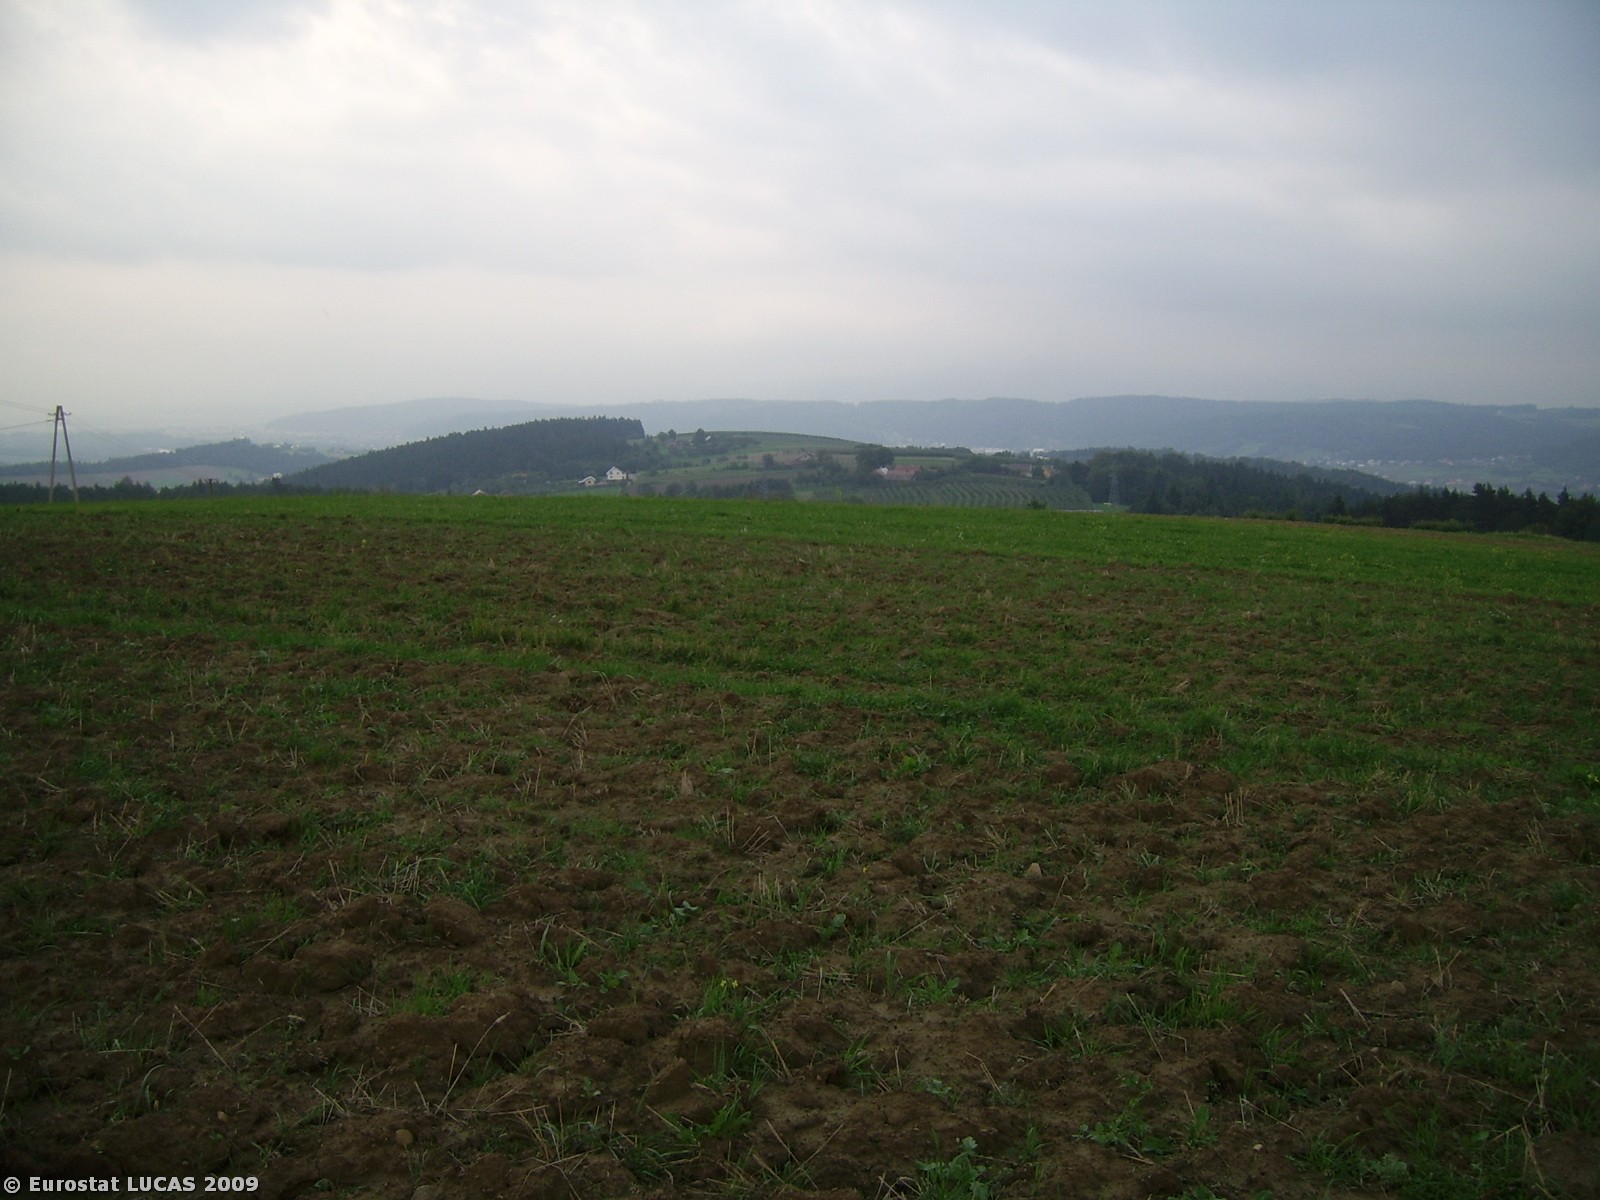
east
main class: Cropland
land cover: Common wheat
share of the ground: < 10 %
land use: Agriculture (excluding fallow land and kitchen gardens)
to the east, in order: Common wheat; Grassland without tree/shrub cover; Common wheat; Grass margins; Potatoes; Grassland without tree/shrub cover; Tracks; Grassland without tree/shrub cover
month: September
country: PL
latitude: 49.5503
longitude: 20.5284
